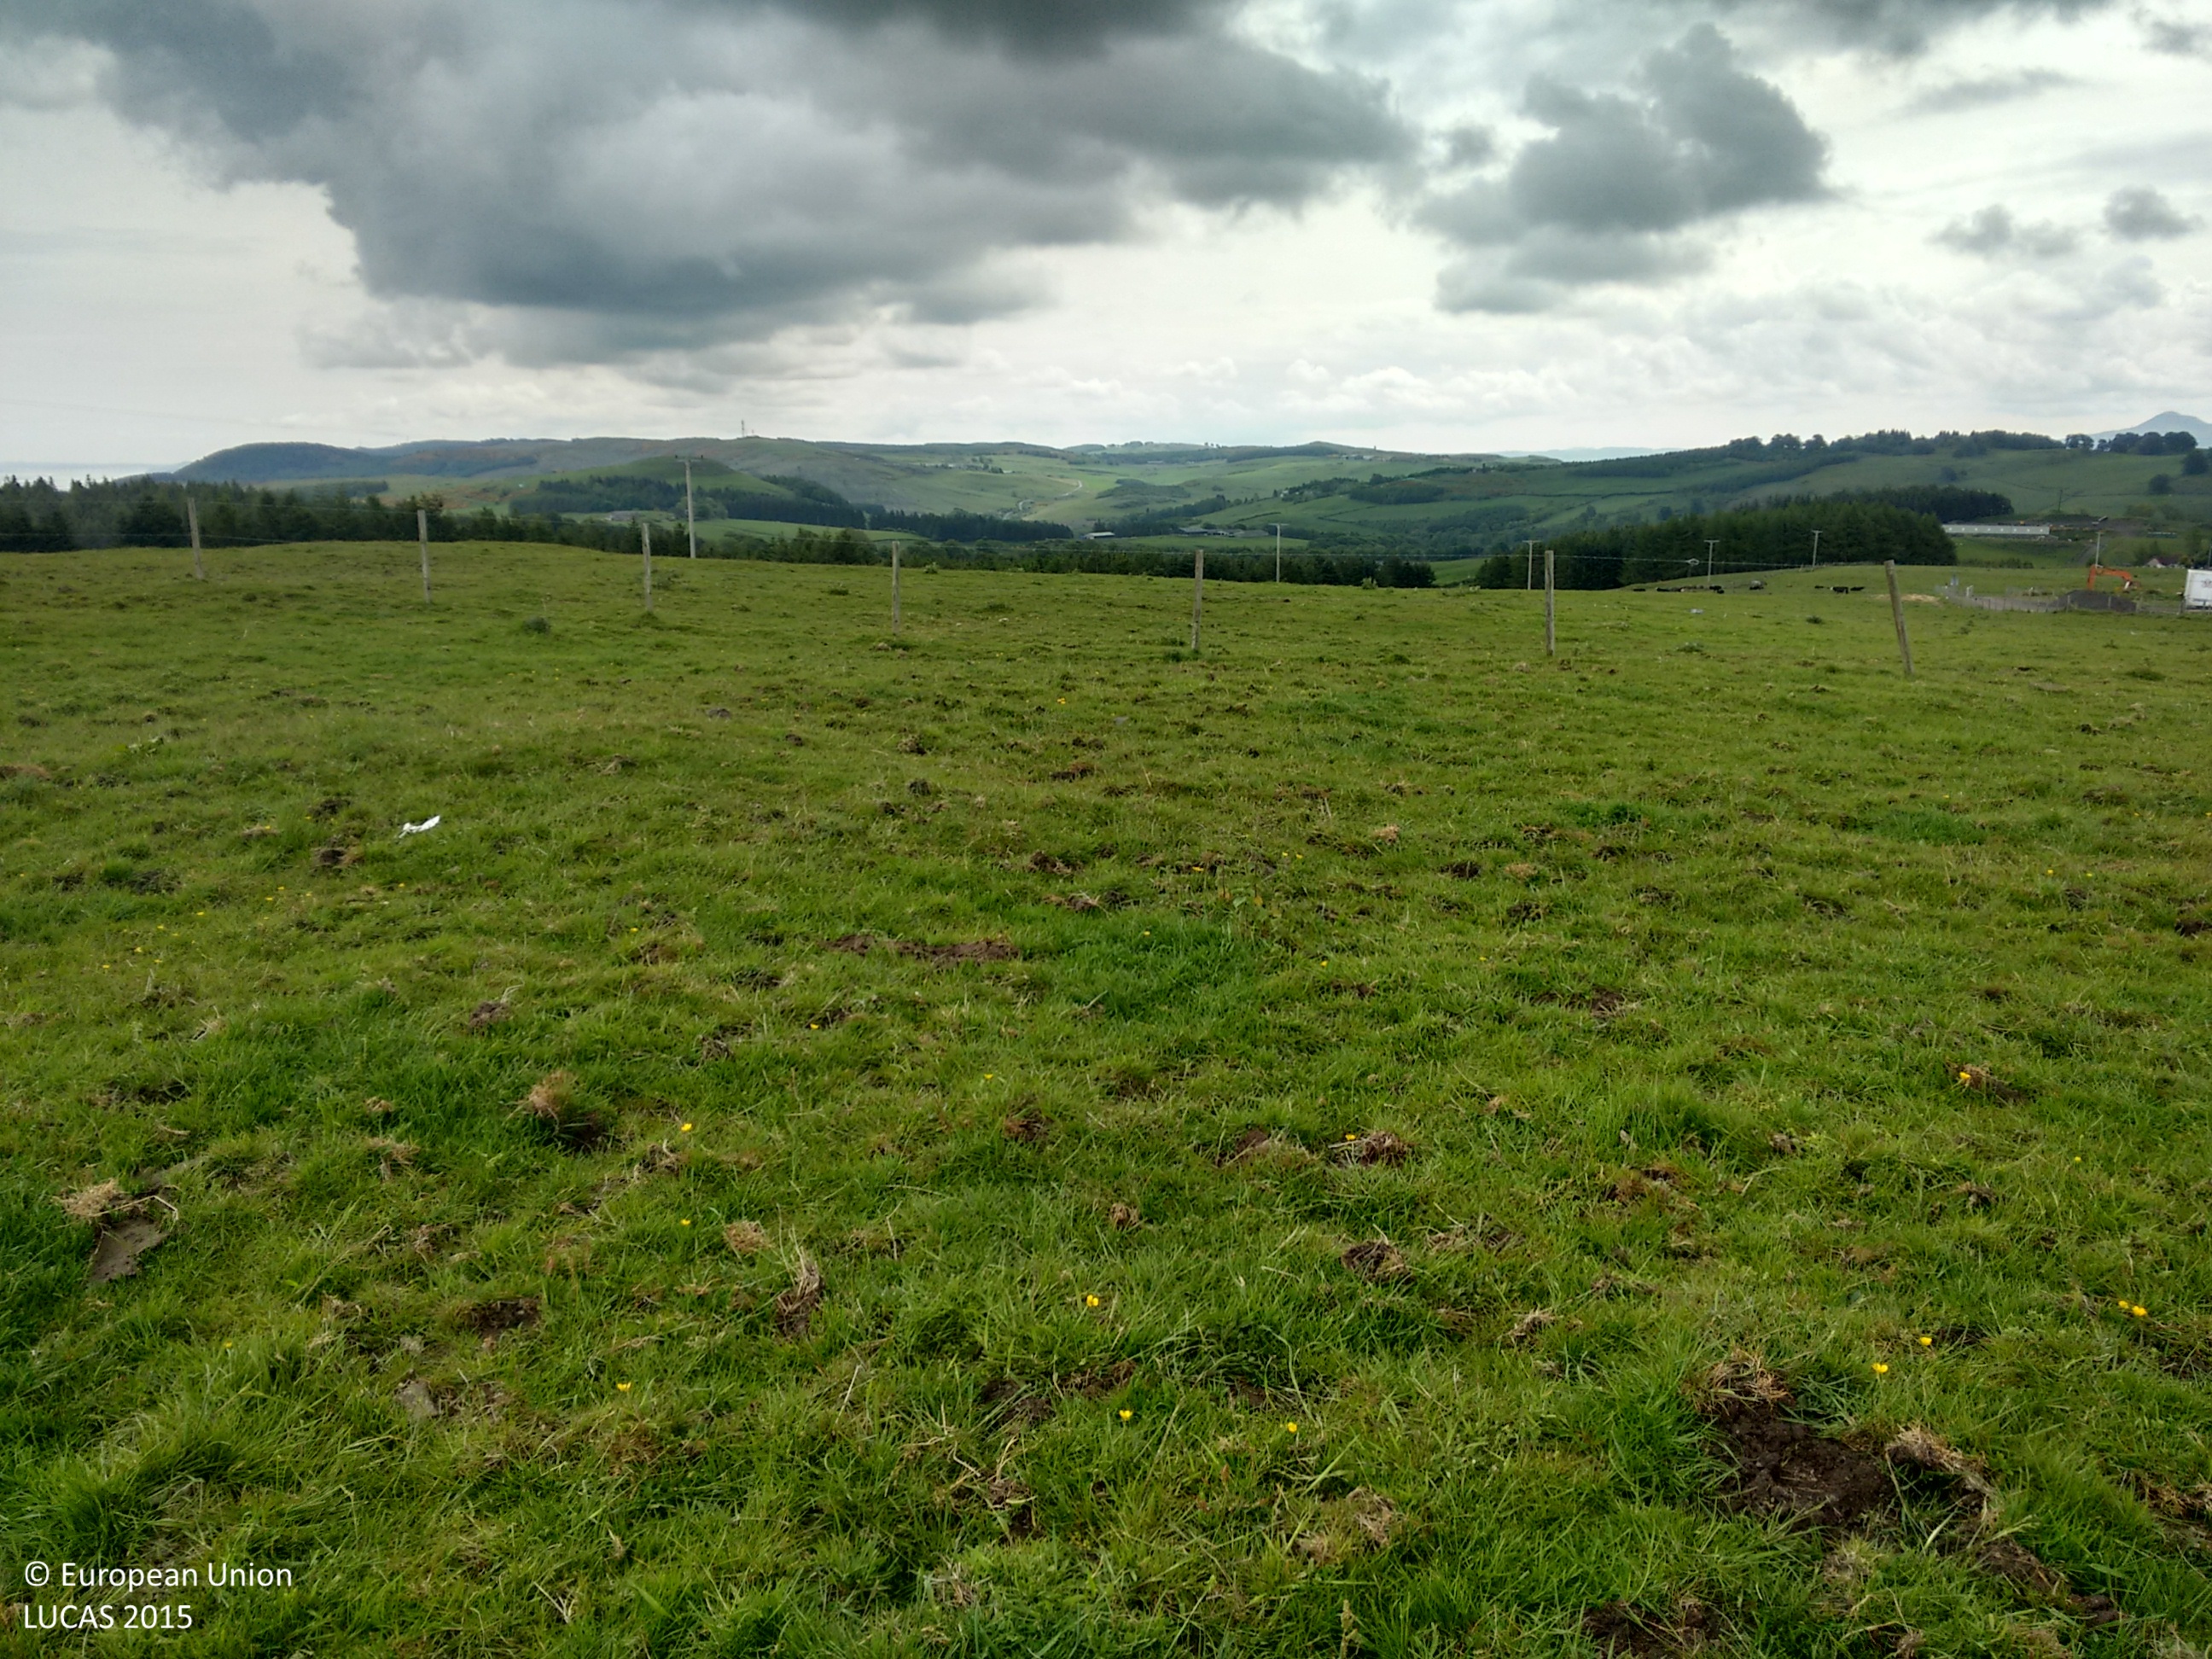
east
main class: Grassland
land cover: Grassland without tree/shrub cover
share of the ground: > 75 %
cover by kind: herbaceous plants 100 %
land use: Agriculture (excluding fallow land and kitchen gardens)
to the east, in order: Grassland without tree/shrub cover; Fences; Grassland without tree/shrub cover; Electric lines; Grassland without tree/shrub cover; Dry stone walls; Grass margins; Fences; Grassland without tree/shrub cover
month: June
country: GB
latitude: 56.3015
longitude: -3.4069
